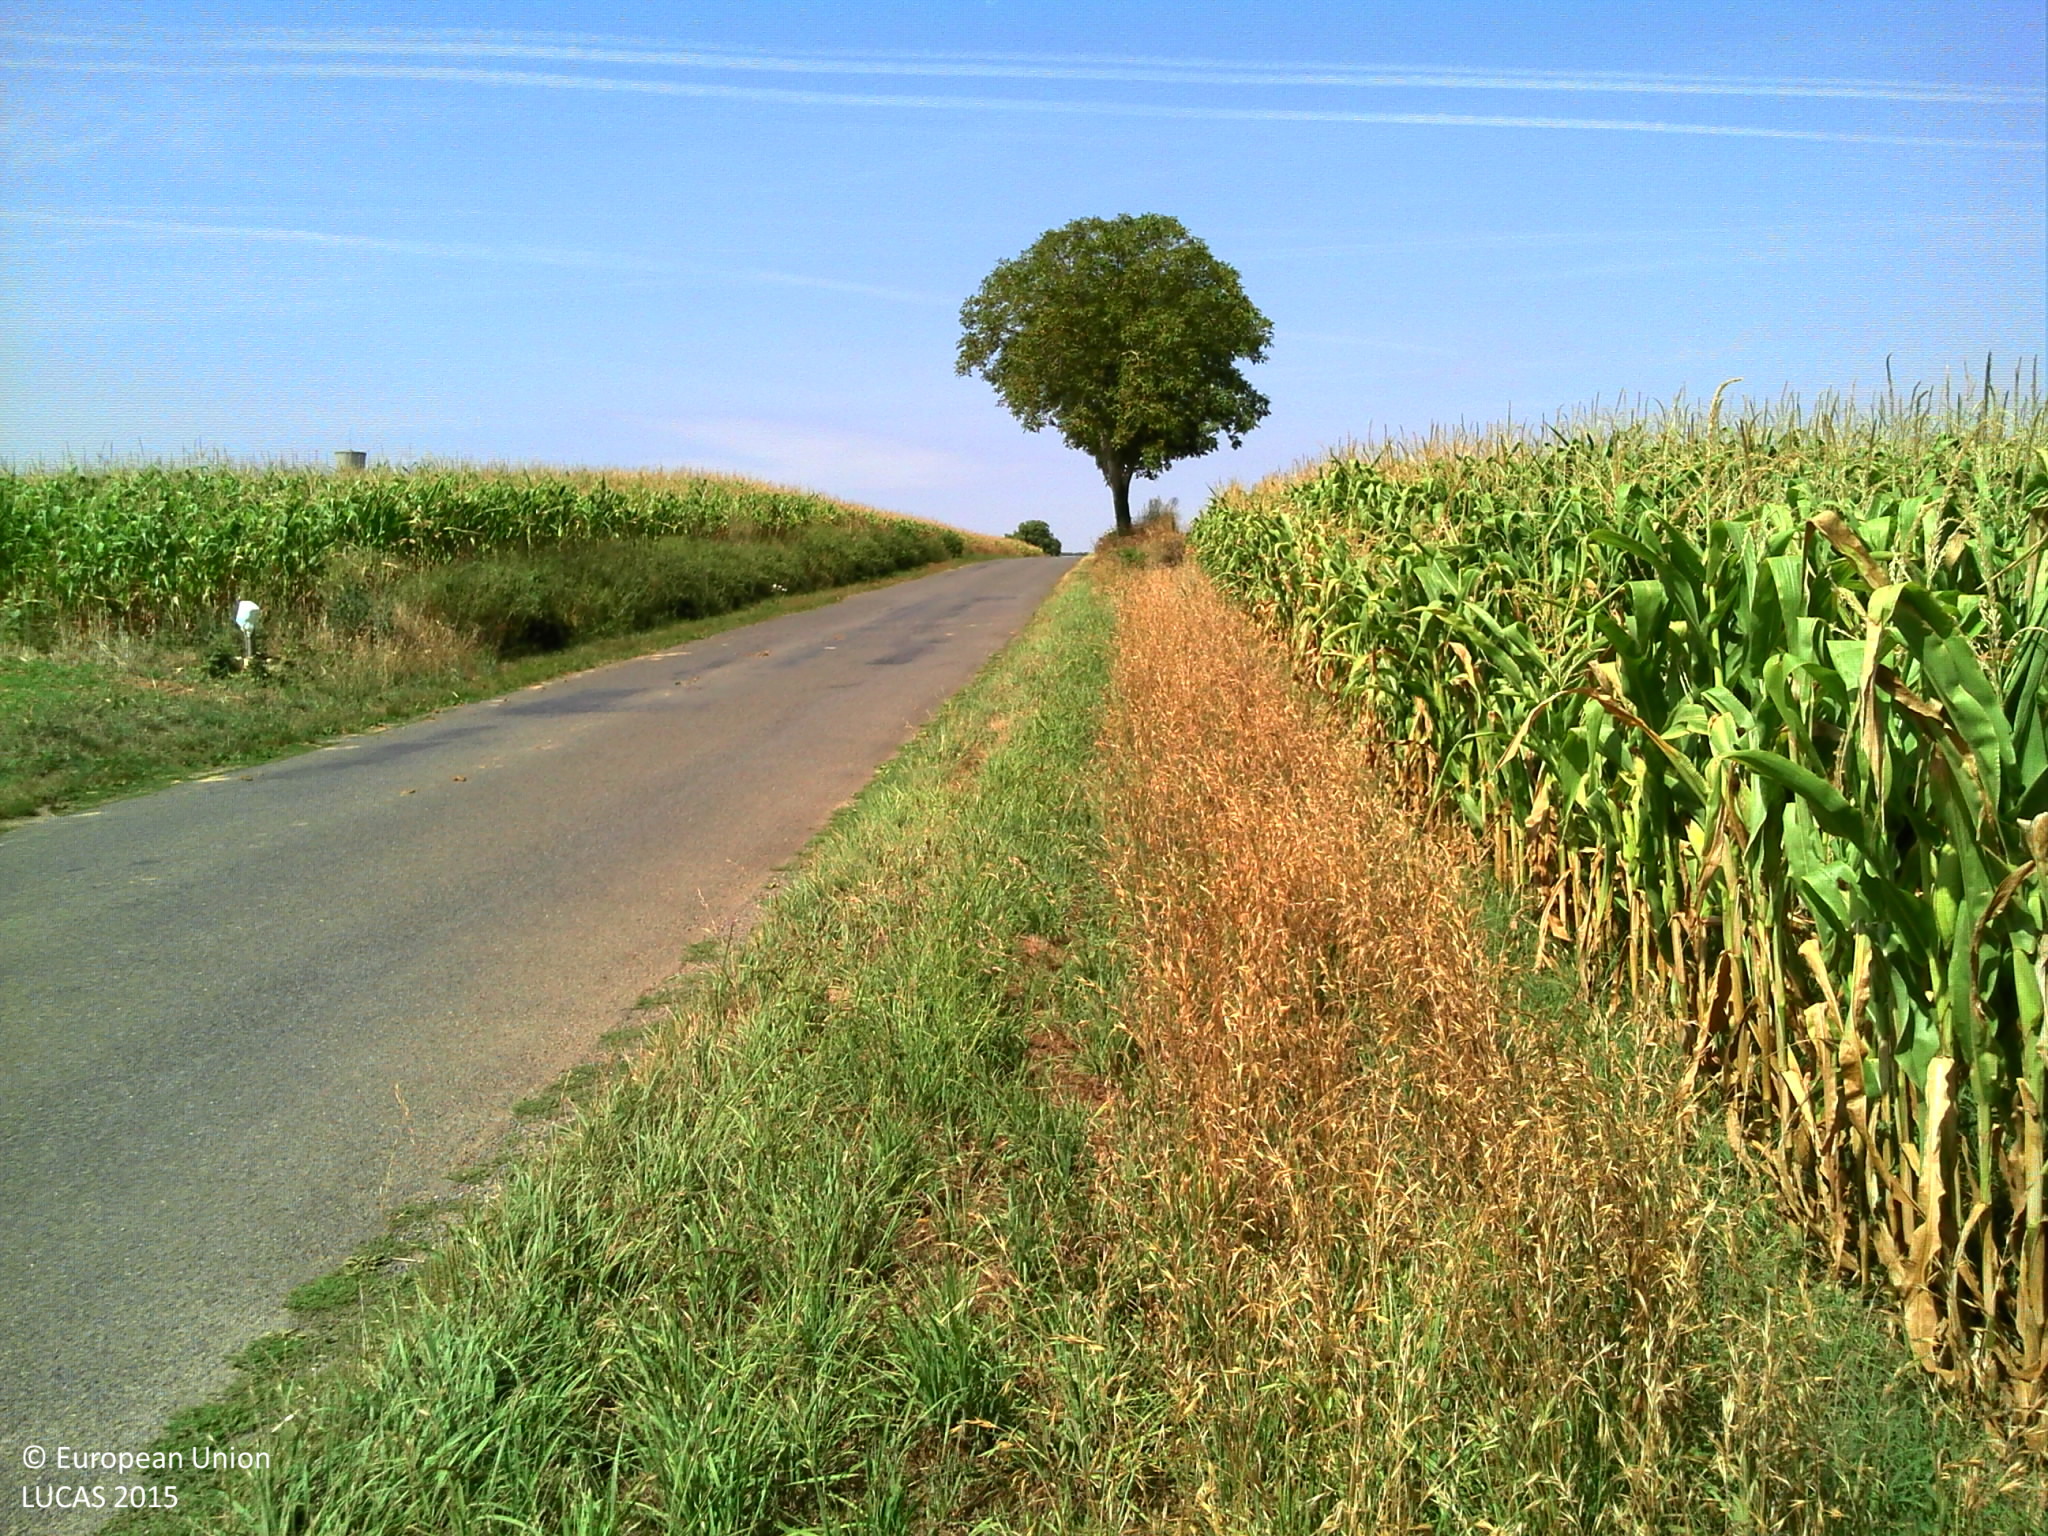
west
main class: Cropland
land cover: Maize
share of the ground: > 75 %
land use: Agriculture (excluding fallow land and kitchen gardens)
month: August
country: FR
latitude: 46.2176
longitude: 0.2985
